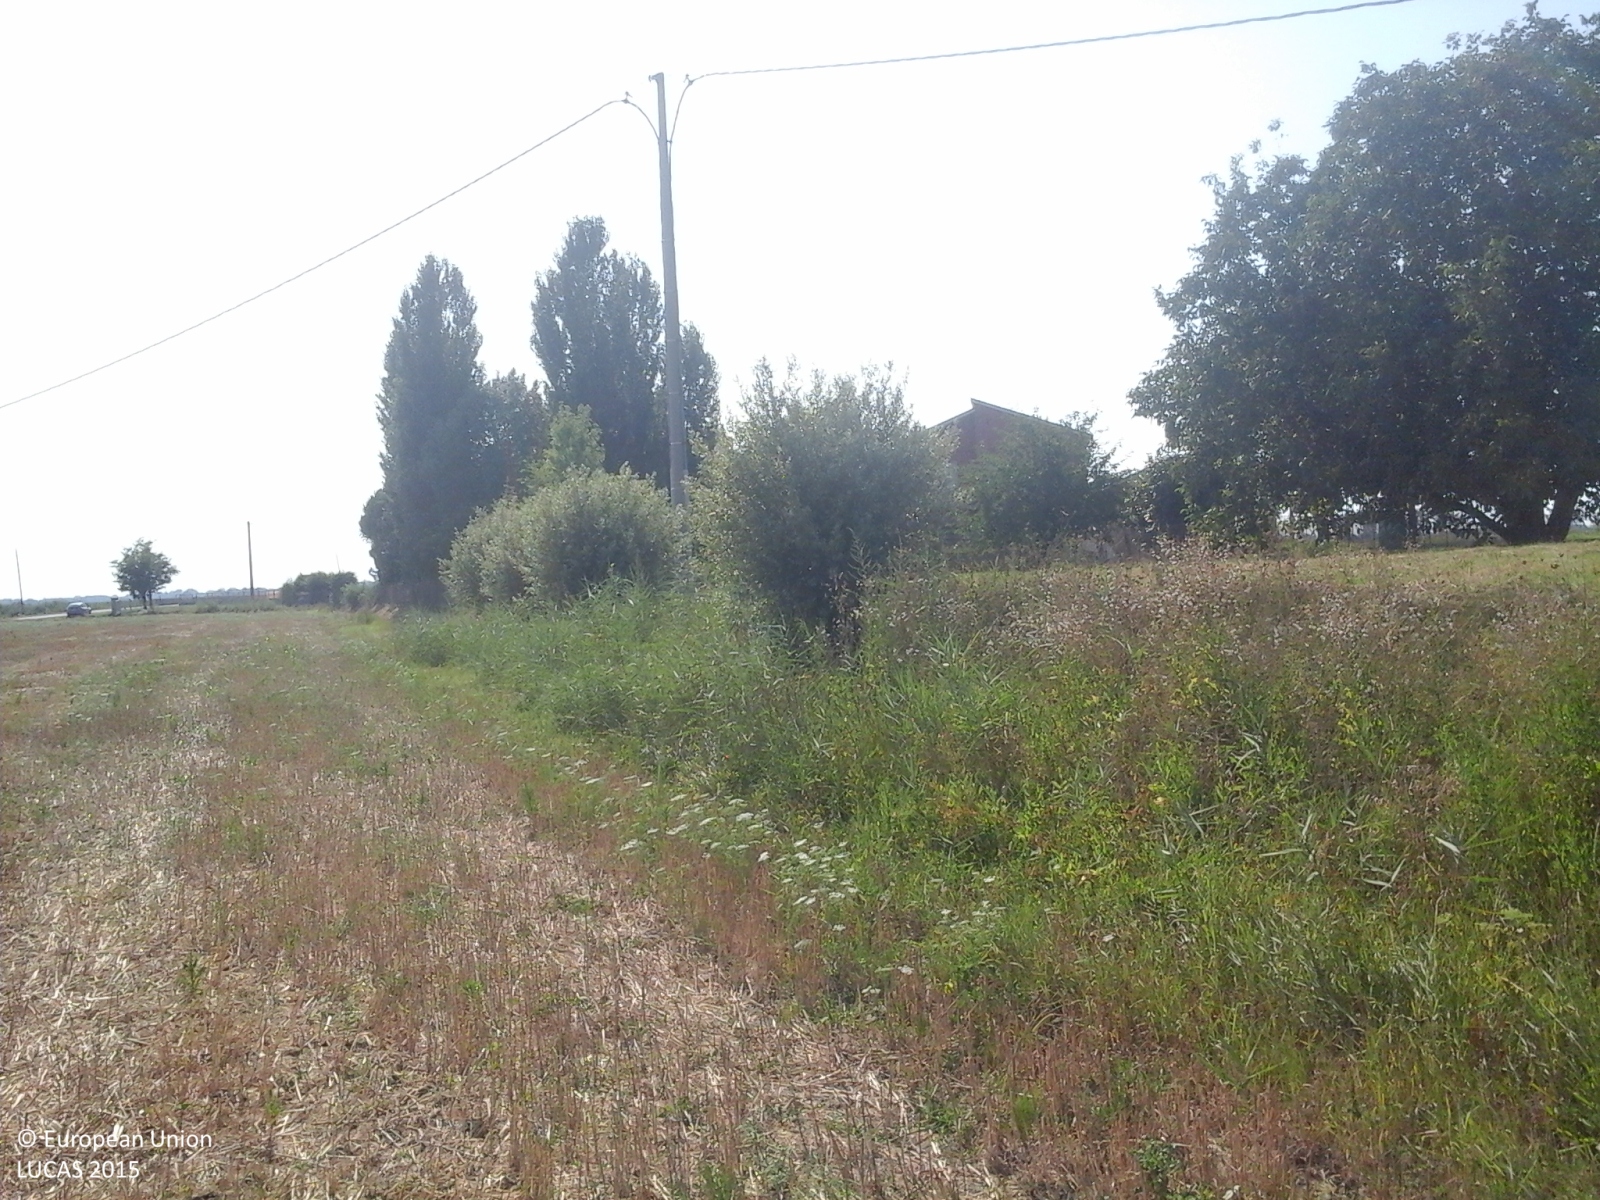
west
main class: Cropland
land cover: Common wheat
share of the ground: > 75 %
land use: Agriculture (excluding fallow land and kitchen gardens)
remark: Harvested field
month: July
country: IT
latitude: 44.5502
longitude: 11.8717
